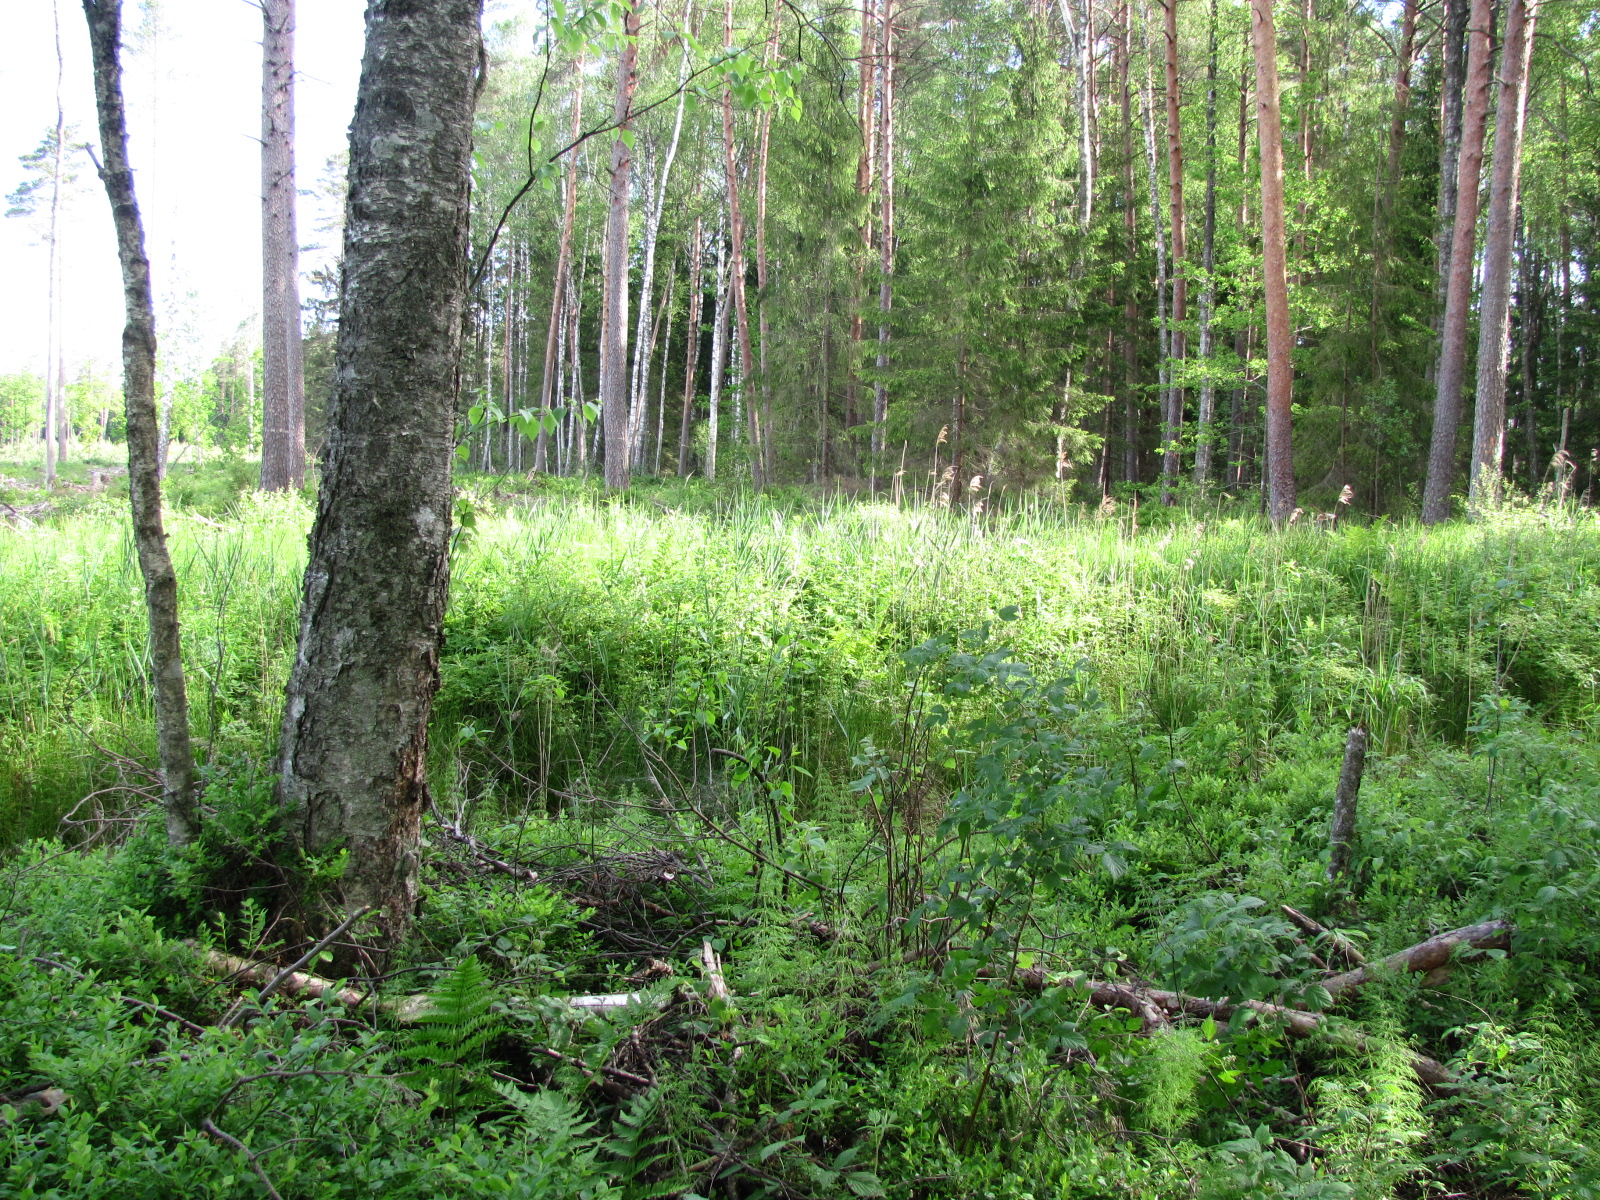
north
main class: Woodland
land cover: Other mixed woodland
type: hemiboreal forest and nemoral coniferous forest and mixed broadleaved-coniferous forest
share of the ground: > 75 %
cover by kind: broadleaved forest trees 45 %, coniferous forest trees 40 %, herbaceous plants 15 %
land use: Forestry
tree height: > 5 m
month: June
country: LV
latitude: 56.7357
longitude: 23.9618
